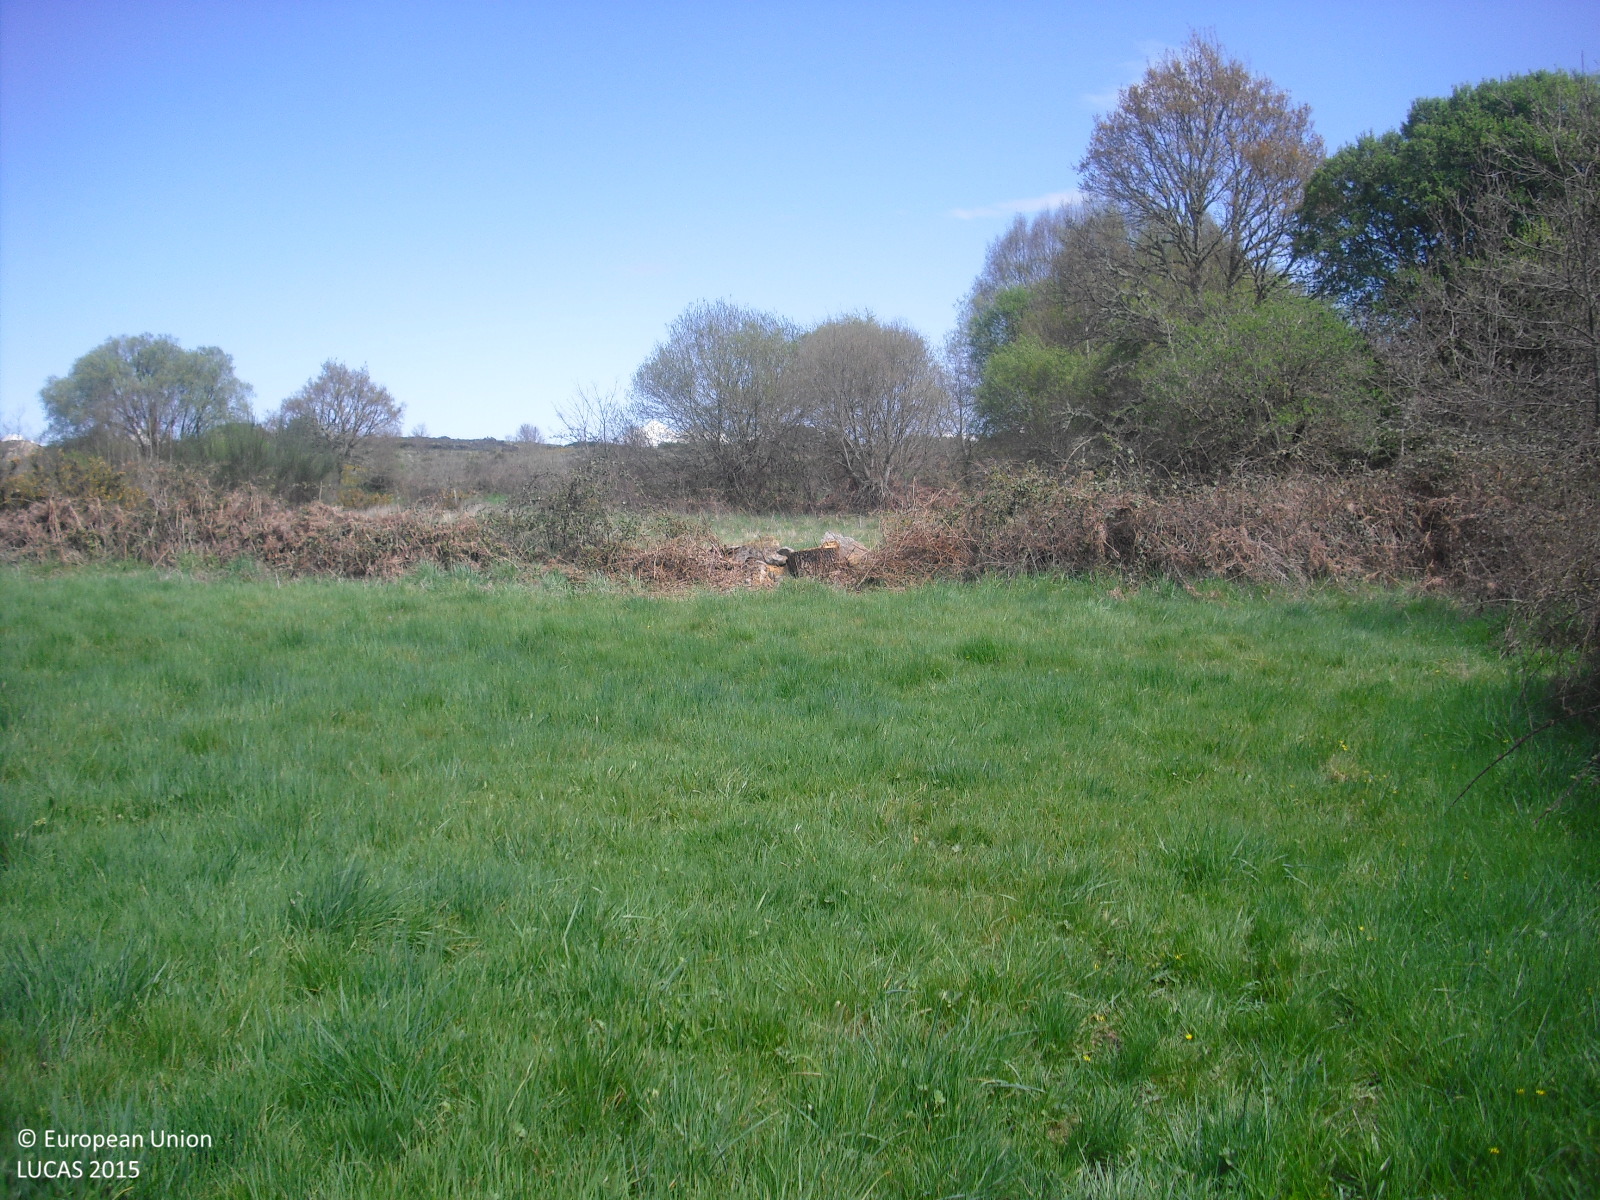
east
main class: Grassland
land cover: Grassland without tree/shrub cover
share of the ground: > 75 %
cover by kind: herbaceous plants 100 %
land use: Agriculture (excluding fallow land and kitchen gardens)
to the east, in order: Grassland without tree/shrub cover; Shruby margins; Dry stone walls; Grassland with sparse tree/shrub cover; Grassland without tree/shrub cover; Broadleaved woodland; Ditches and canals; Broadleaved woodland; Dry stone walls; Broadleaved woodland; Grassland without tree/shrub cover; Shruby margins; Dry stone walls; Shruby margins; Grassland without tree/shrub cover; Shruby margins; Dry stone walls; Single bushes/trees; Ditches and canals; Grassland with sparse tree/shrub cover
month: April
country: ES
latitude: 41.9978
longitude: -7.8299
